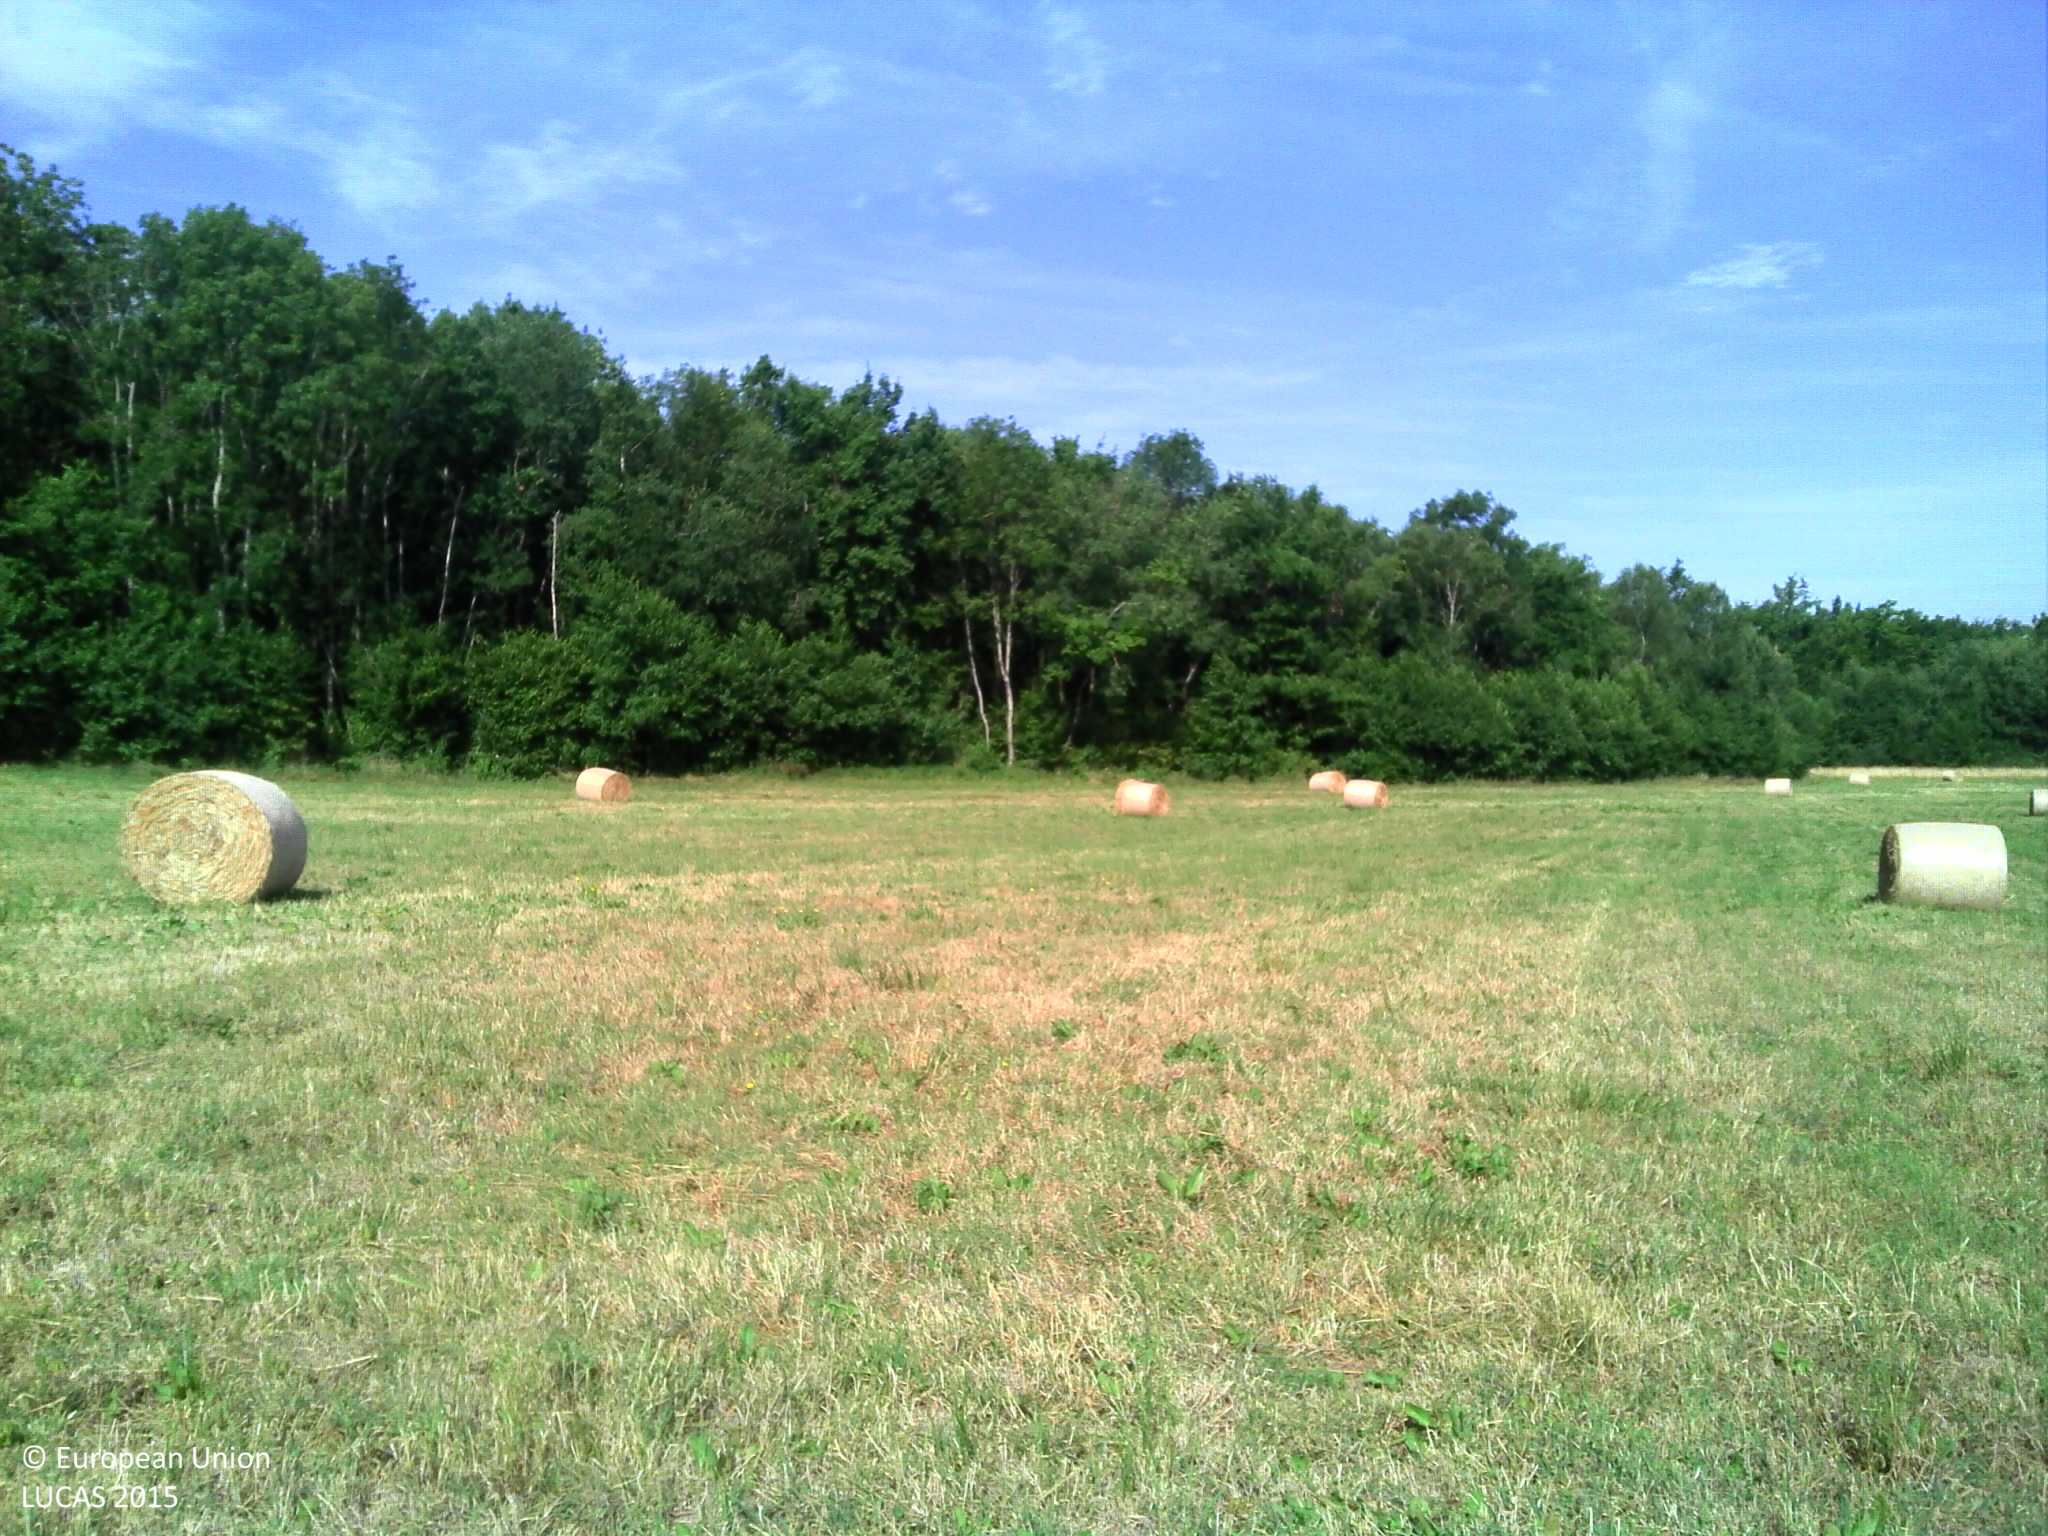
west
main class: Grassland
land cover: Grassland without tree/shrub cover
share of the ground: > 75 %
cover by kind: herbaceous plants 100 %
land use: Agriculture (excluding fallow land and kitchen gardens)
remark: Harvested field
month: July
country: FR
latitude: 45.3025
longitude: 5.1460
